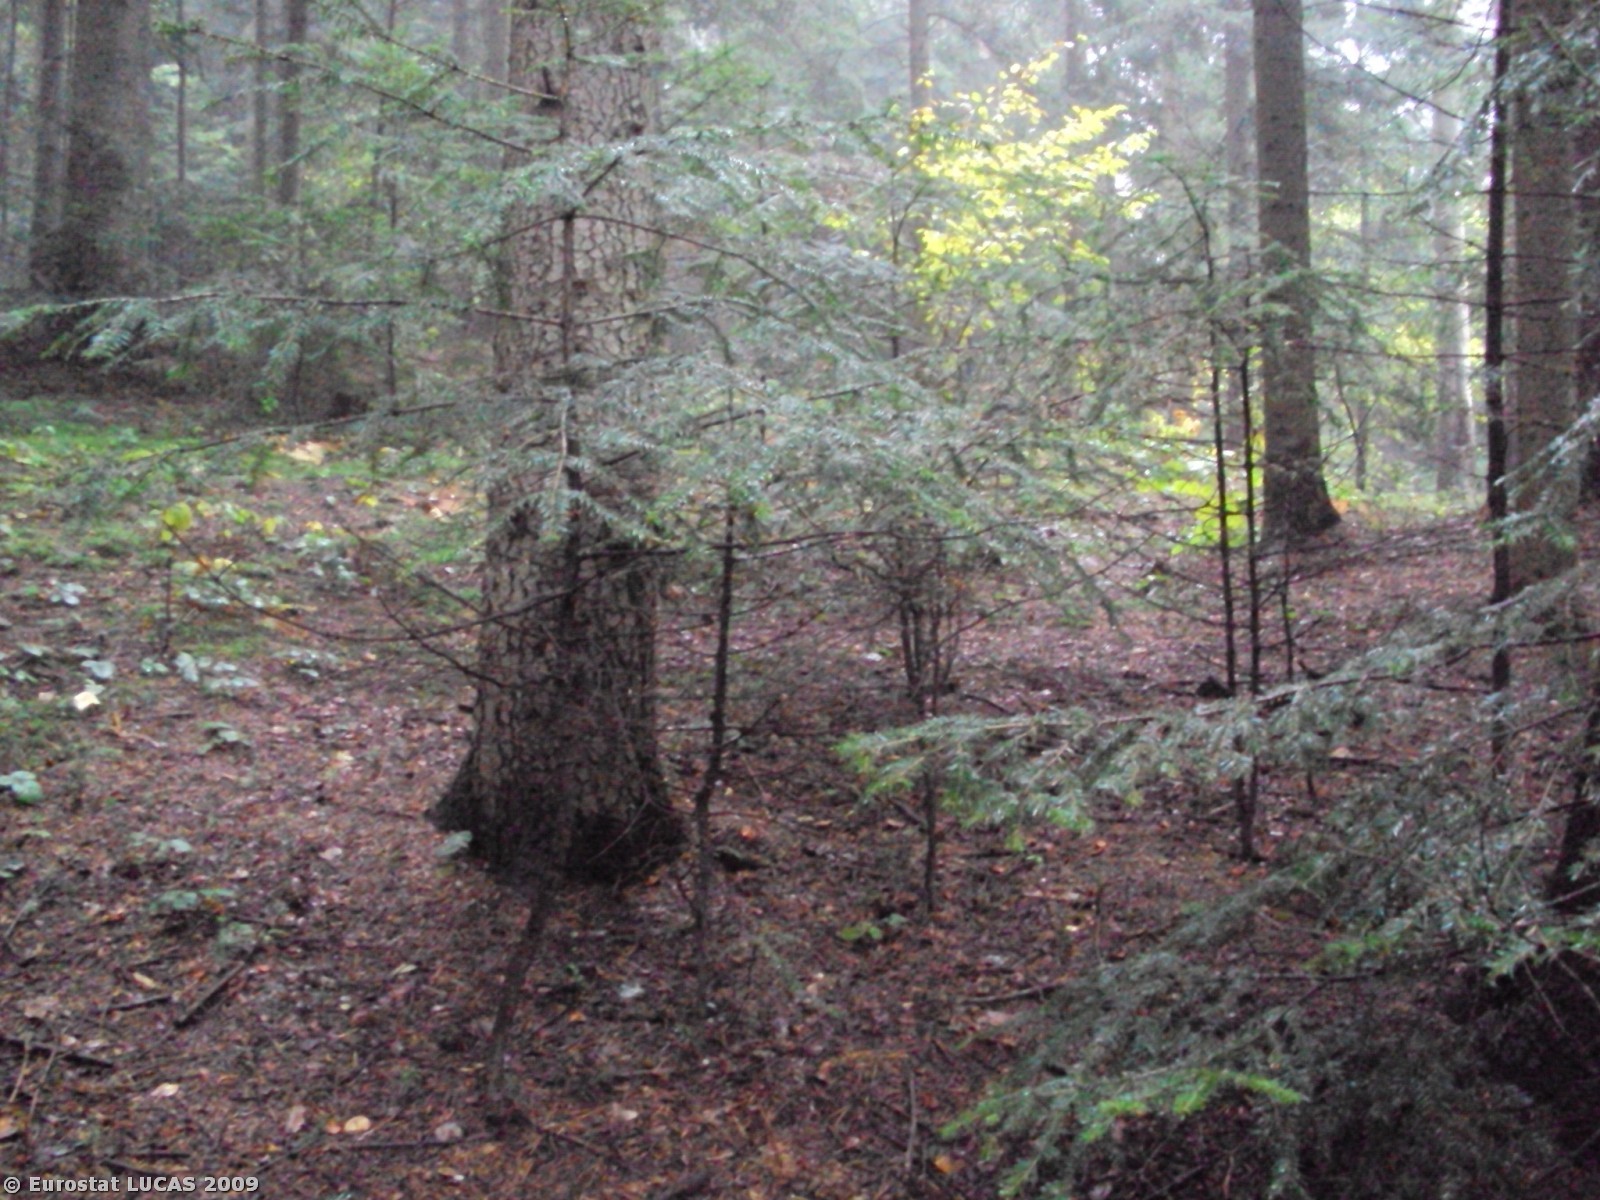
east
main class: Woodland
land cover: Coniferous woodland
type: hemiboreal forest and nemoral coniferous forest and mixed broadleaved-coniferous forest
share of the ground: > 75 %
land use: Unused
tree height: > 5 m
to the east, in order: Coniferous woodland; Tracks; Coniferous woodland
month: September
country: PL
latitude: 49.7304
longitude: 20.1471
